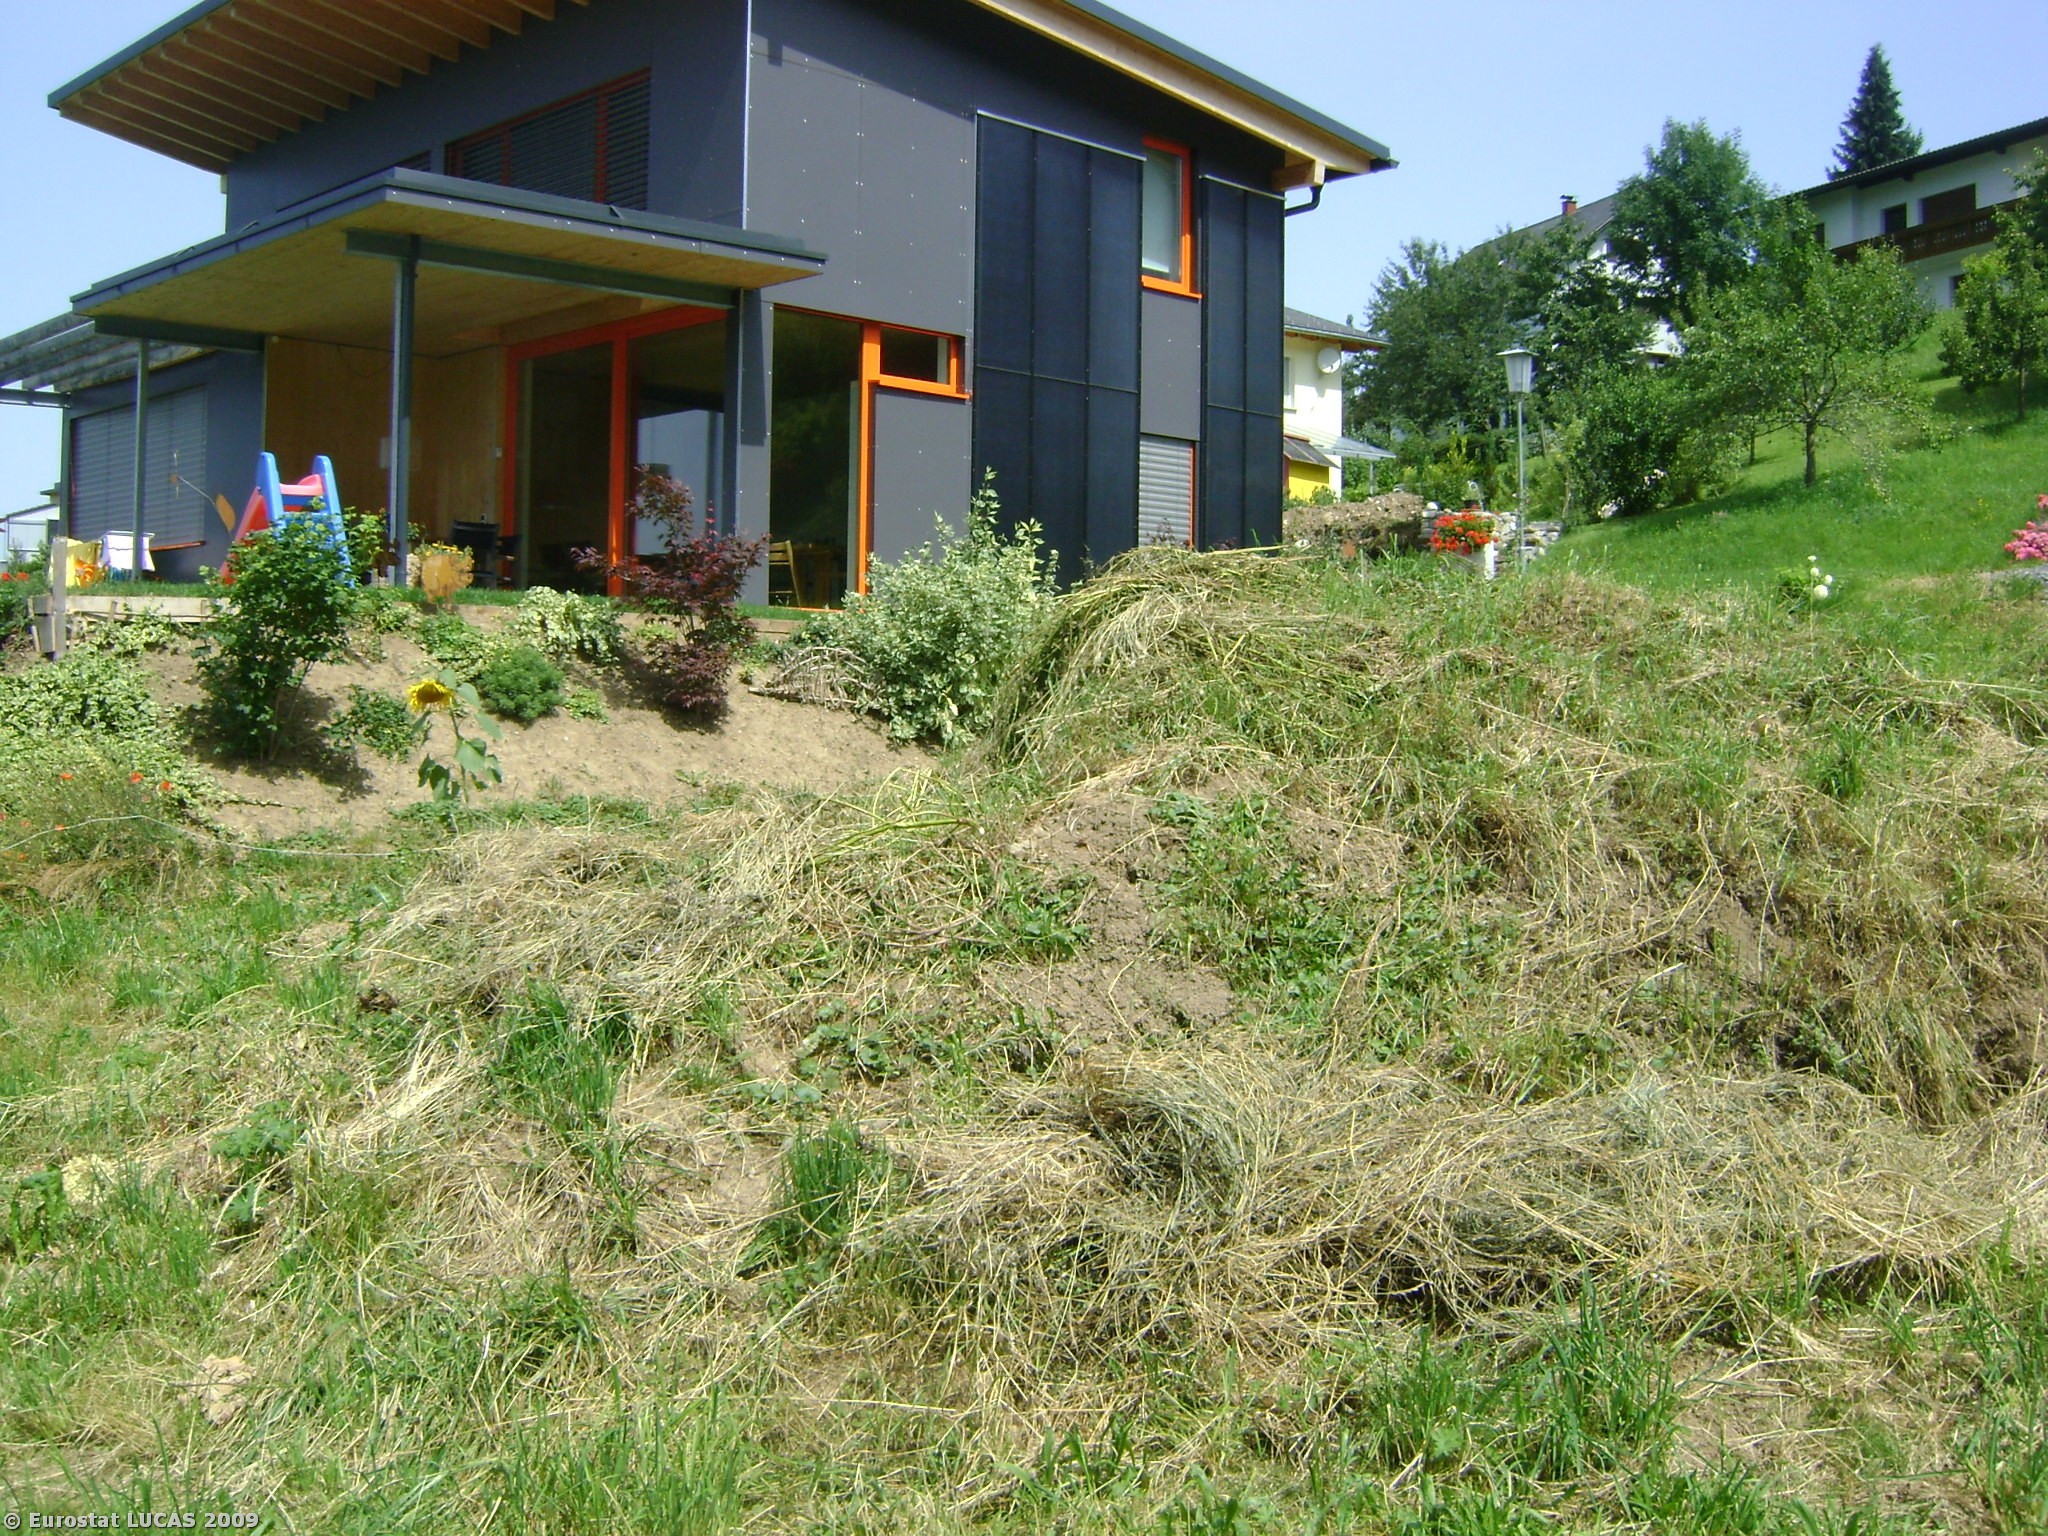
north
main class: Grassland
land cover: Grassland without tree/shrub cover
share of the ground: > 75 %
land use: Agriculture (excluding fallow land and kitchen gardens)
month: July
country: AT
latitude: 47.2511
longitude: 9.6700
